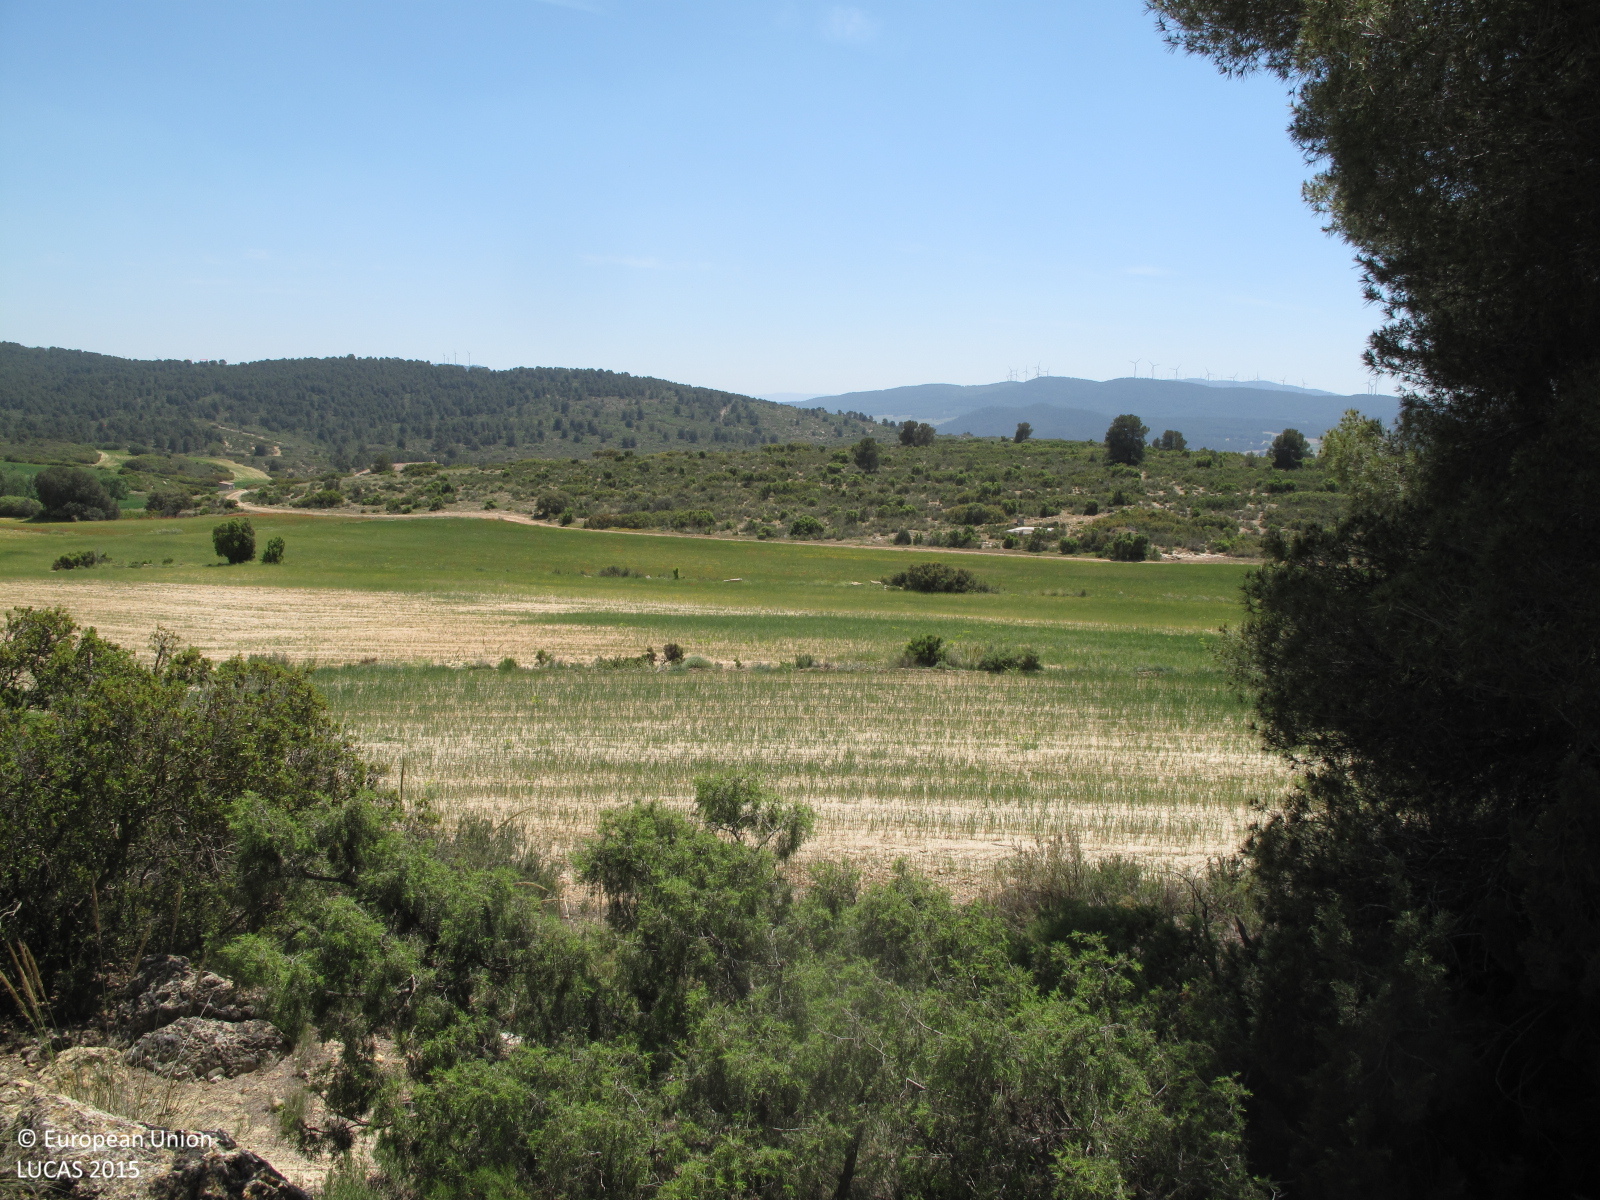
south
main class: Woodland
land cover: Pine dominated coniferous woodland
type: coniferous forest of the mediterranean region
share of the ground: 25 - 50 %
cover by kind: coniferous forest trees 40 %, shrubs 20 %, herbaceous plants 20 %, consolidated bare surface 20 %
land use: Semi-natural and natural areas not in use
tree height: > 5 m
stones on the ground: 25 - 50 %
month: May
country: ES
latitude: 38.8646
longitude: -0.9766
